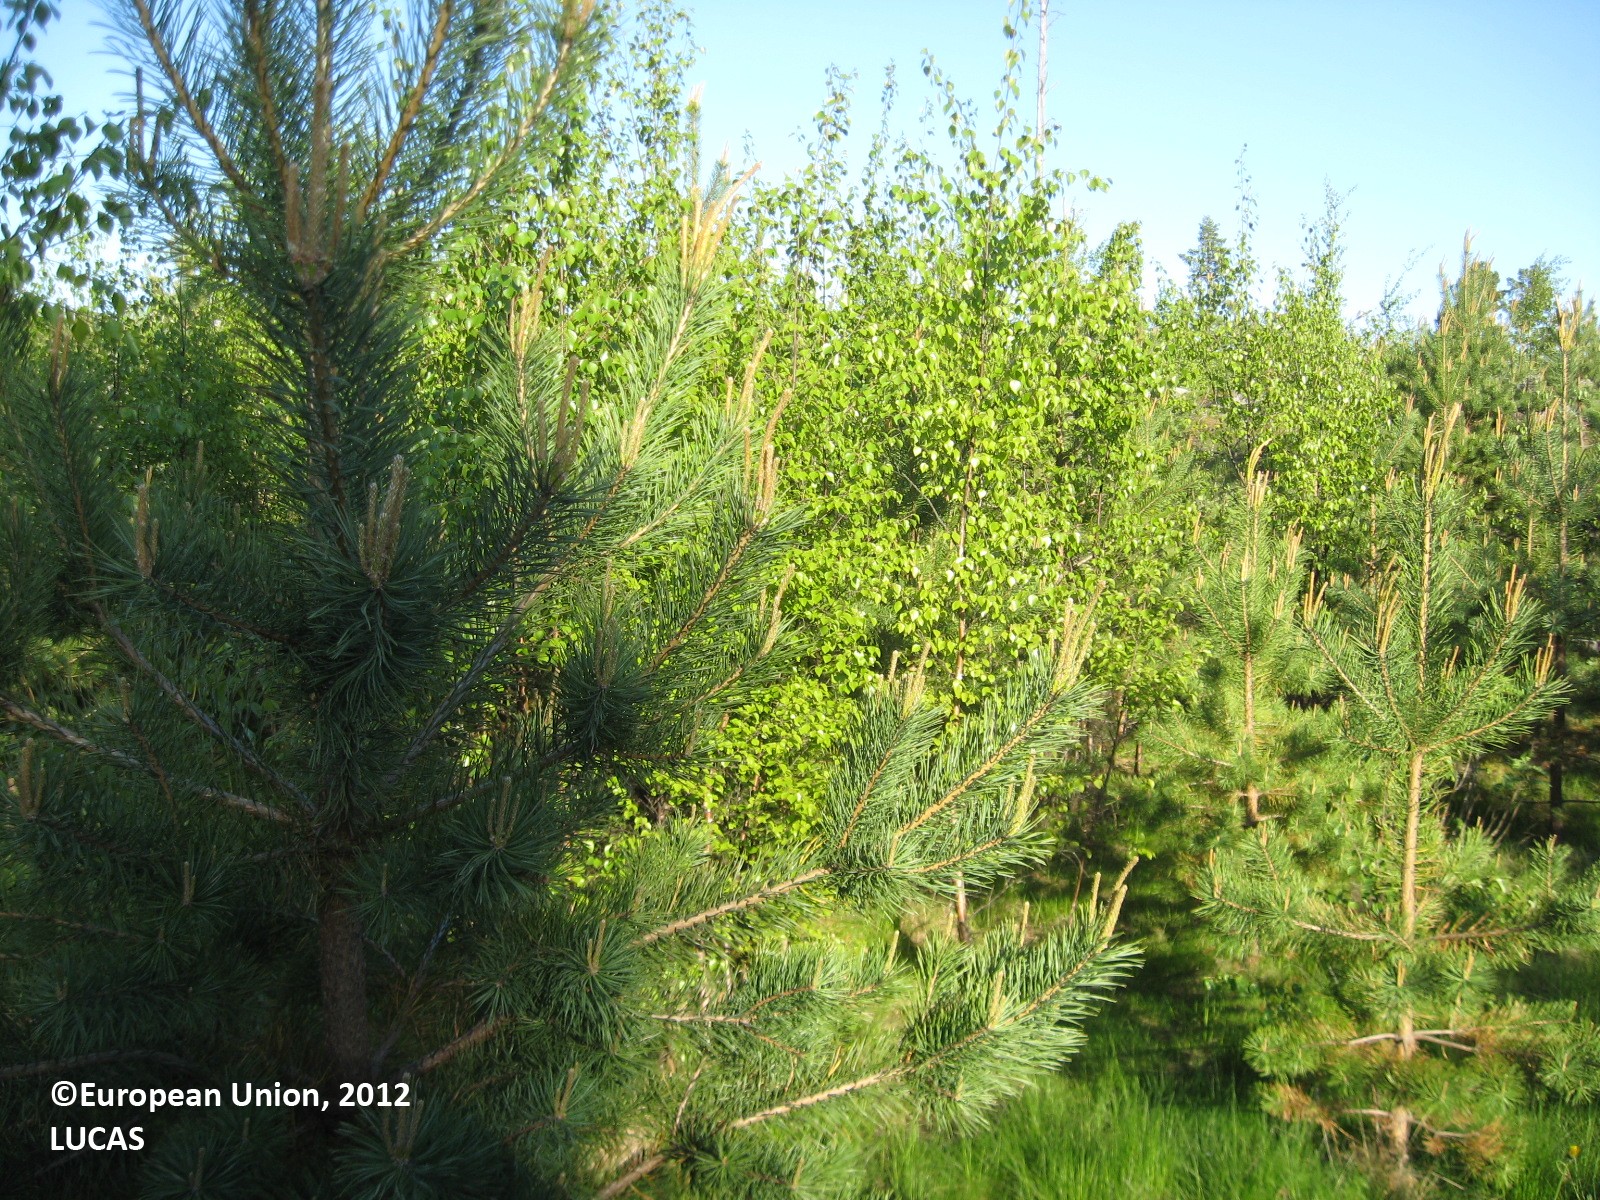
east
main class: Woodland
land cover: Pine dominated mixed woodland
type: boreal forest
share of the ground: 50 - 75 %
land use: Forestry
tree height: < 5 m
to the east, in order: Pine dominated mixed woodland; Pine dominated coniferous woodland; Pine dominated mixed woodland
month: June
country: FI
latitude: 63.1777
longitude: 21.7007
